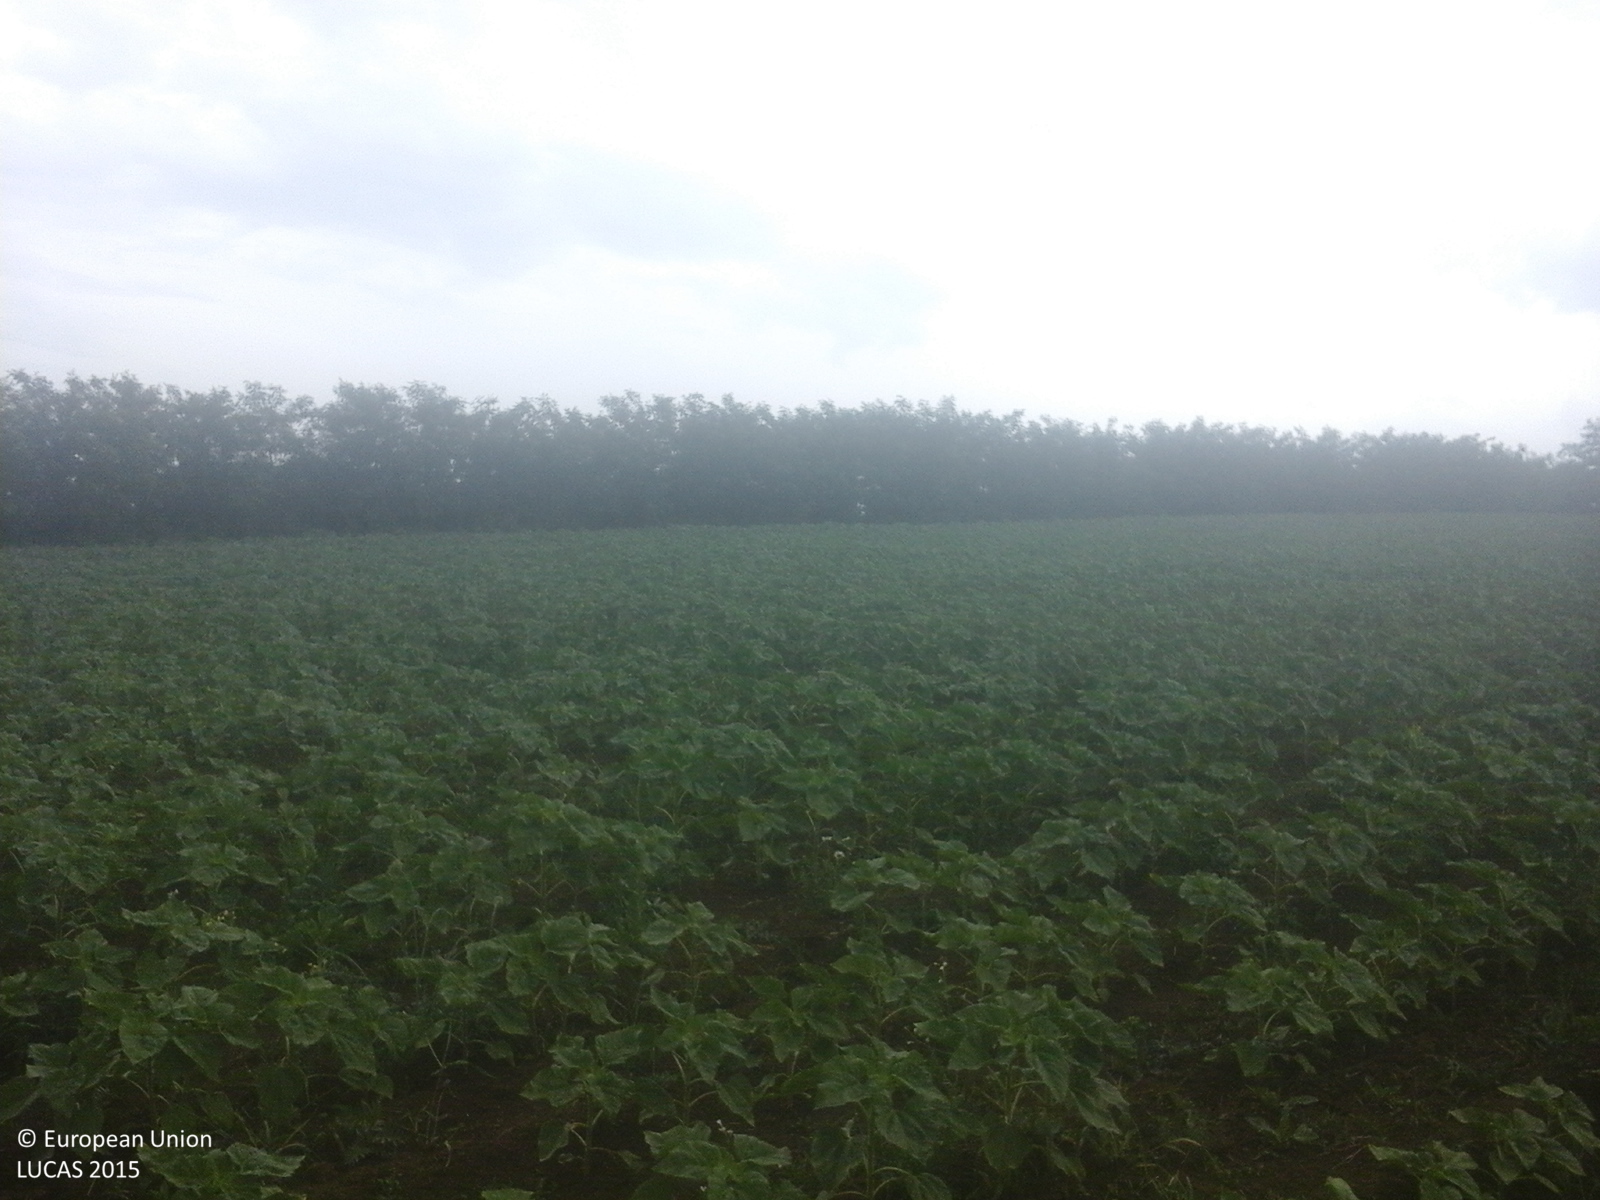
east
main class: Cropland
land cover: Sunflower
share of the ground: 25 - 50 %
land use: Agriculture (excluding fallow land and kitchen gardens)
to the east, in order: Sunflower; Grass margins; Shrubland with sparse tree cover; Grass margins; Sunflower; Other fruit trees and berries; Artificial constructions in urban areas
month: June
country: RO
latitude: 47.0019
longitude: 26.4041
